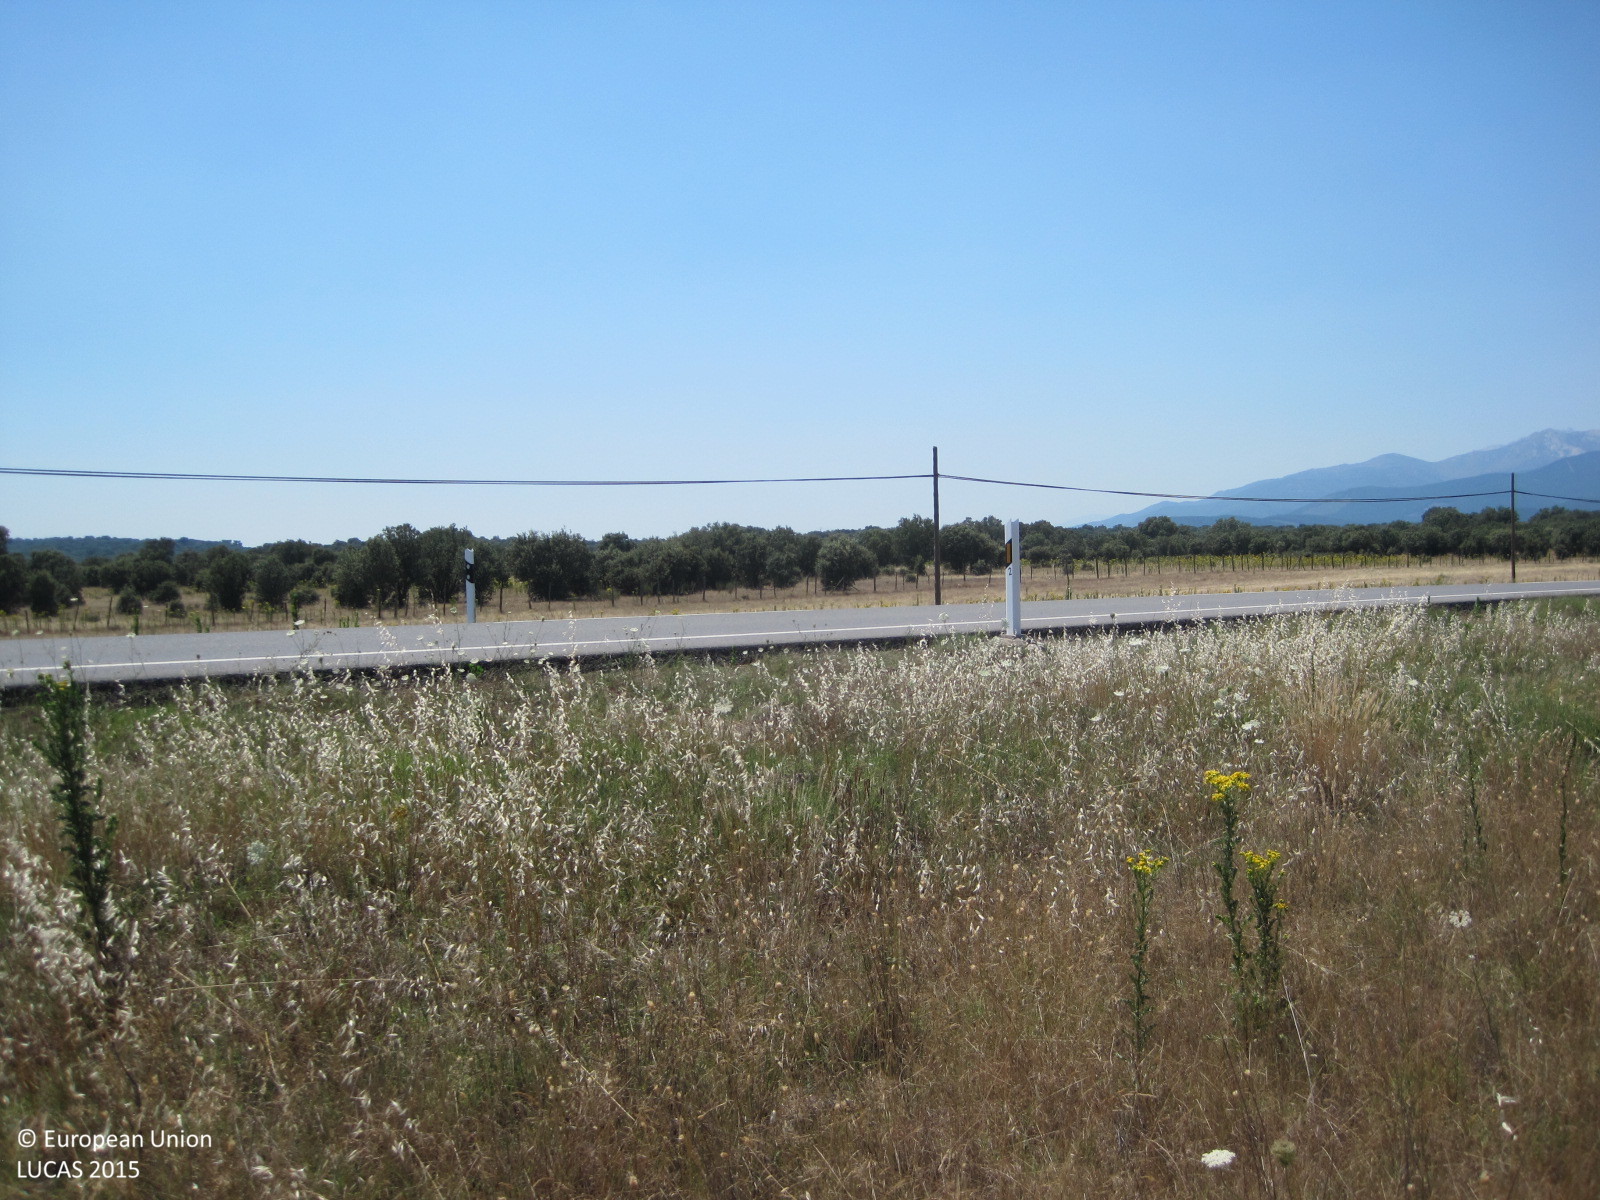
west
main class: Grassland
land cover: Grassland with sparse tree/shrub cover
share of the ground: > 75 %
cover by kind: herbaceous plants 95 %, coniferous forest trees 5 %
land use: Agriculture (excluding fallow land and kitchen gardens)
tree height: < 5 m
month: June
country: ES
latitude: 40.1680
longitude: -5.0252
